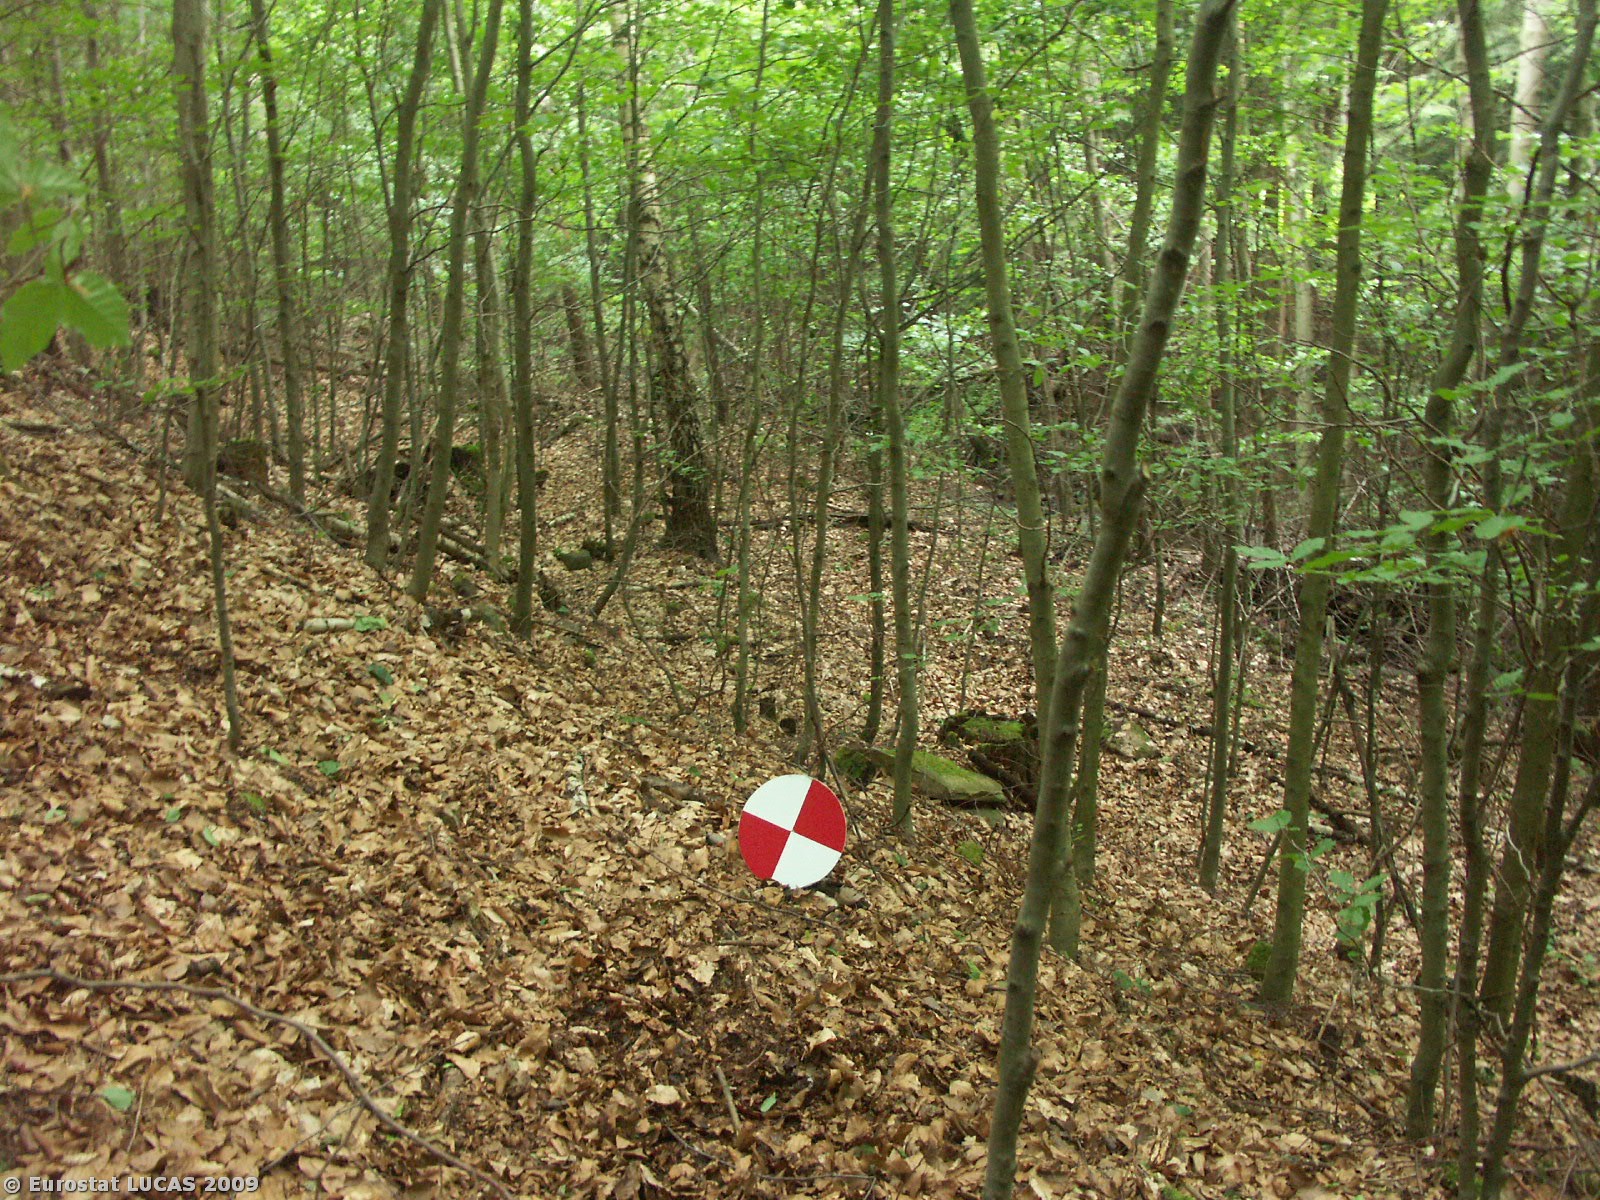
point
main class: Woodland
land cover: Broadleaved woodland
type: beech forest
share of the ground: > 75 %
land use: Forestry
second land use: Nature reserves
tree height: > 5 m
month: May
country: CZ
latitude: 48.8775
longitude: 14.3232
